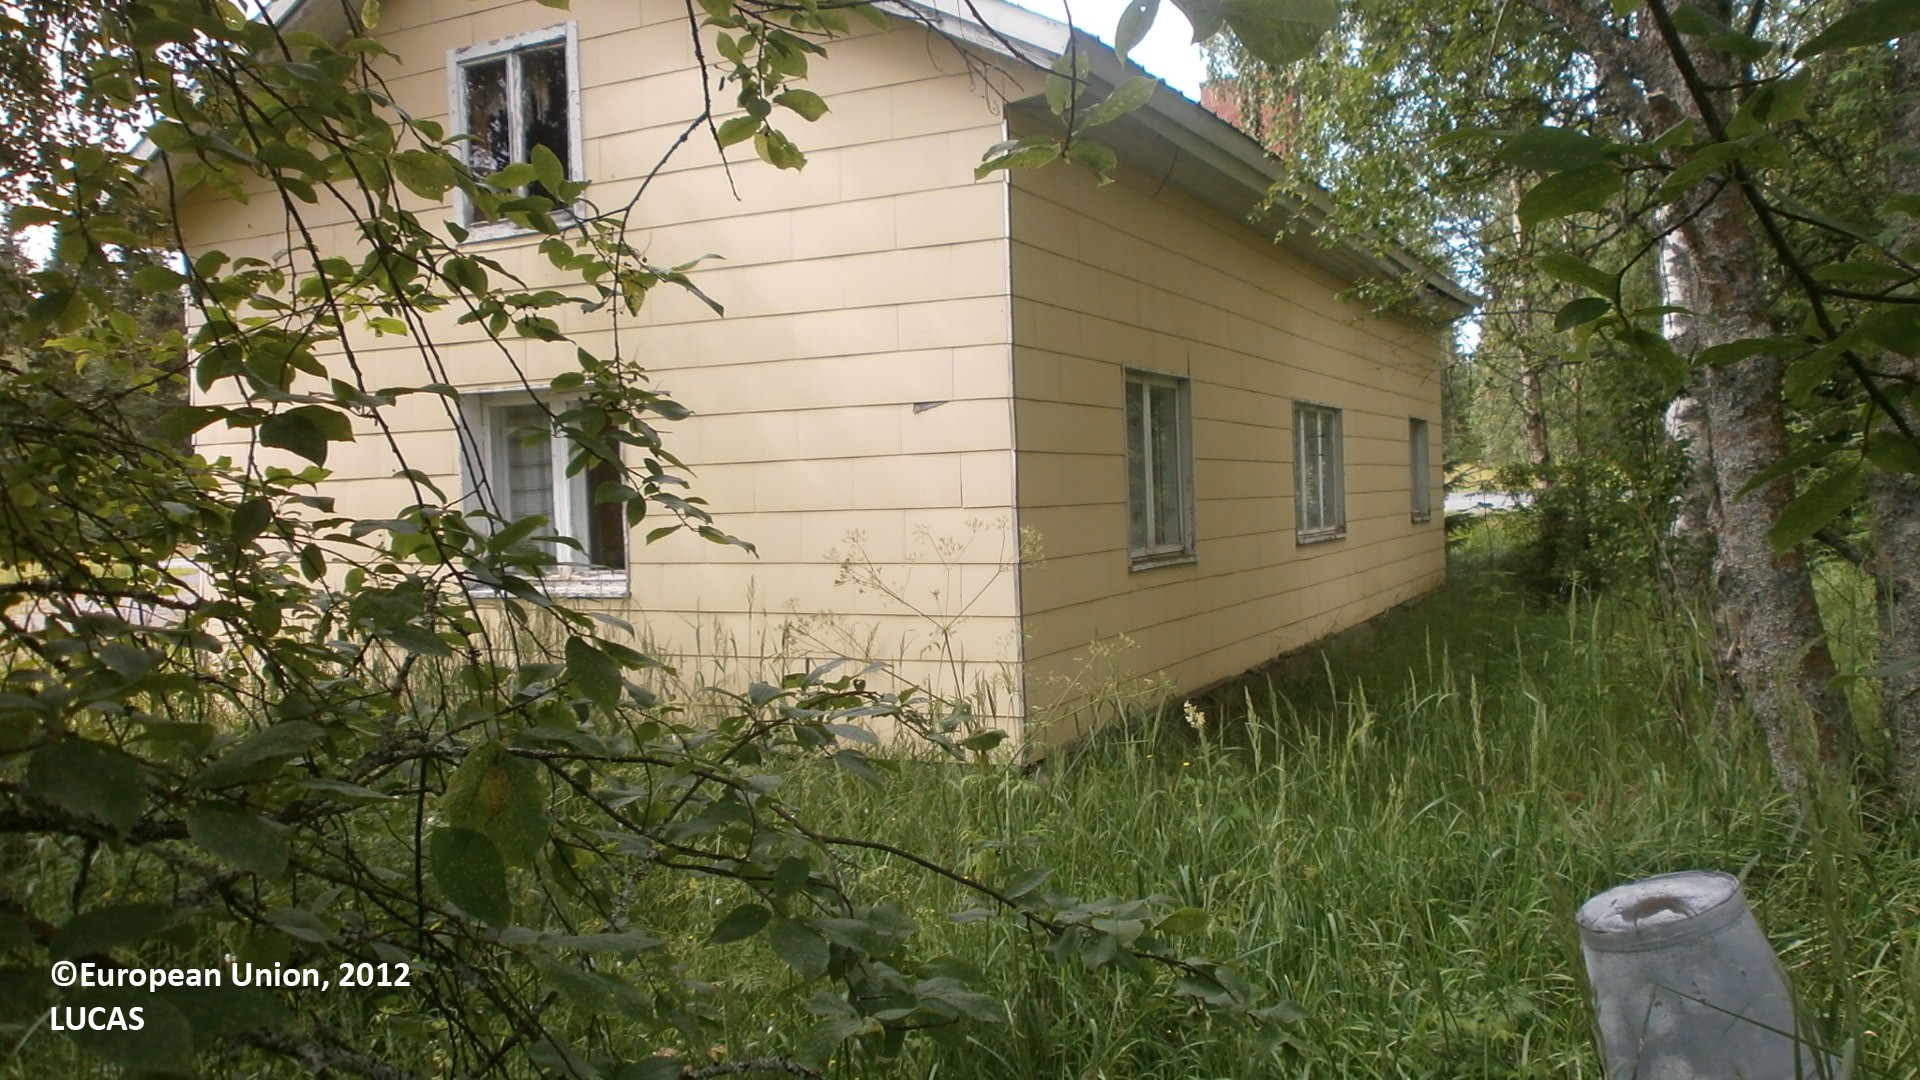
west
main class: Woodland
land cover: Broadleaved woodland
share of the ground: 10 - 25 %
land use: Residential
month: July
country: FI
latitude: 64.2555
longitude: 24.3690
